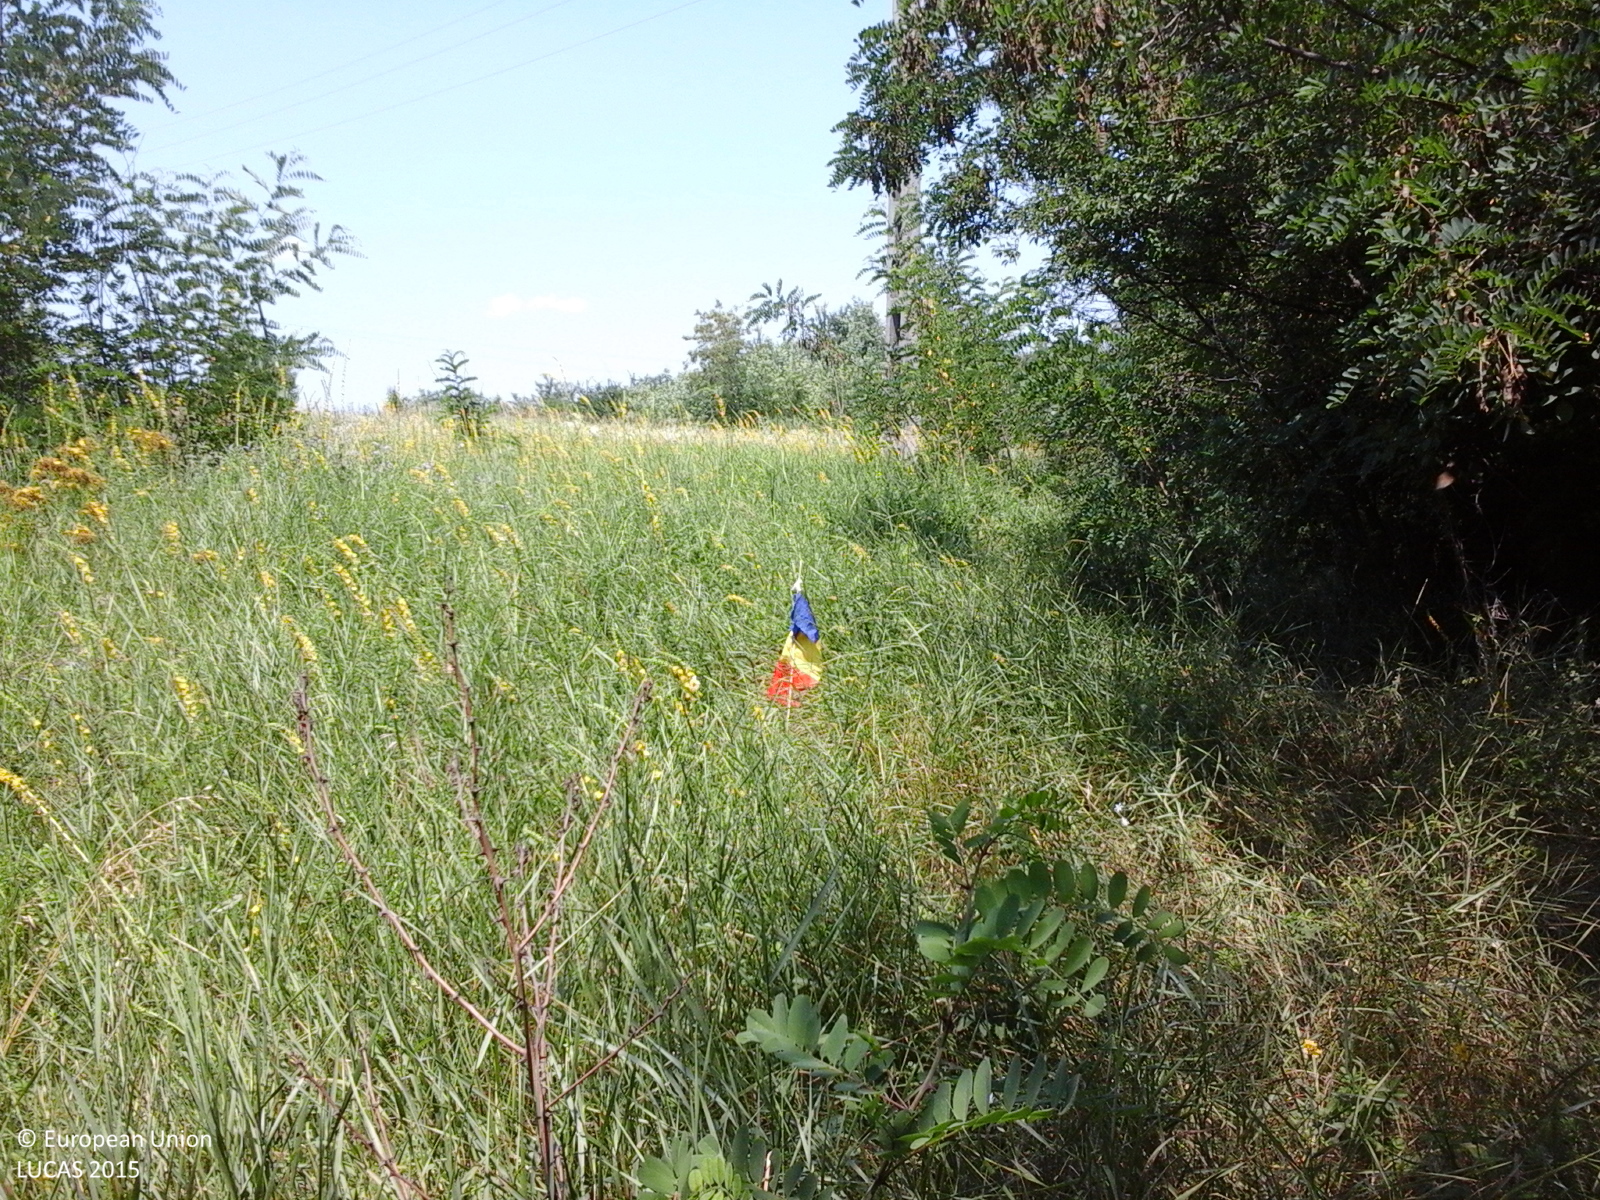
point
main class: Woodland
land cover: Broadleaved woodland
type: thermophilous deciduous forest
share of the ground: > 75 %
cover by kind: broadleaved forest trees 85 %, herbaceous plants 10 %, shrubs 5 %
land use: Forestry
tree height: > 5 m
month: July
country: RO
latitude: 44.6881
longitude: 24.5718
